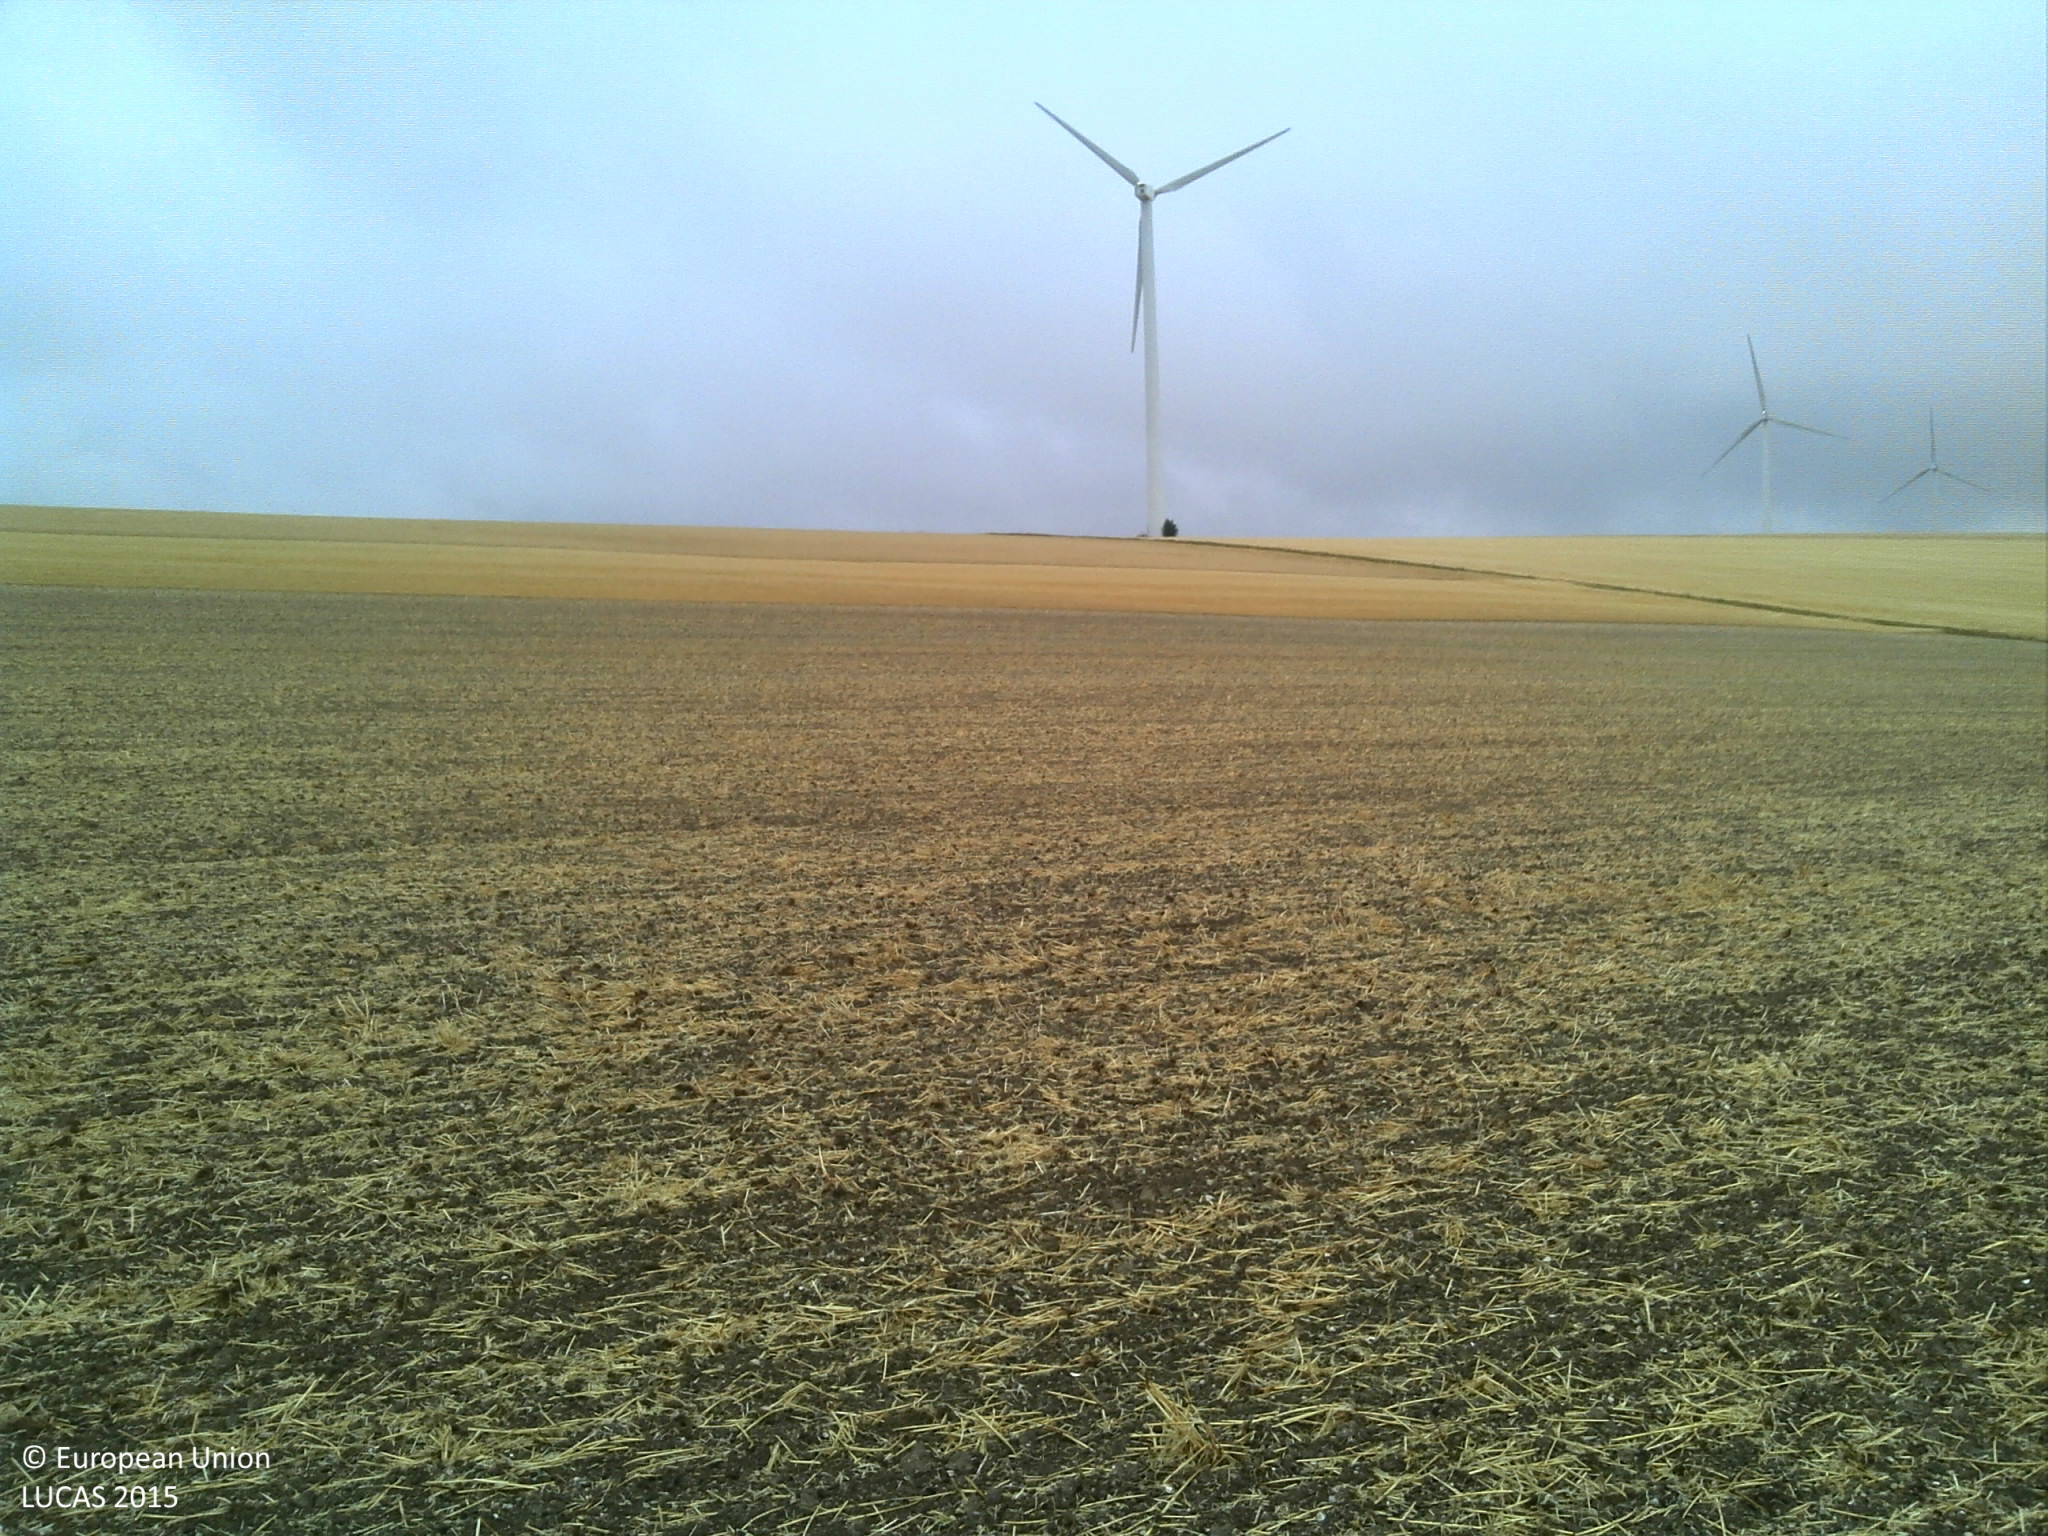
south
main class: Cropland
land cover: Common wheat
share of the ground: > 75 %
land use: Agriculture (excluding fallow land and kitchen gardens)
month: August
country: FR
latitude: 48.8326
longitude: 4.6433
